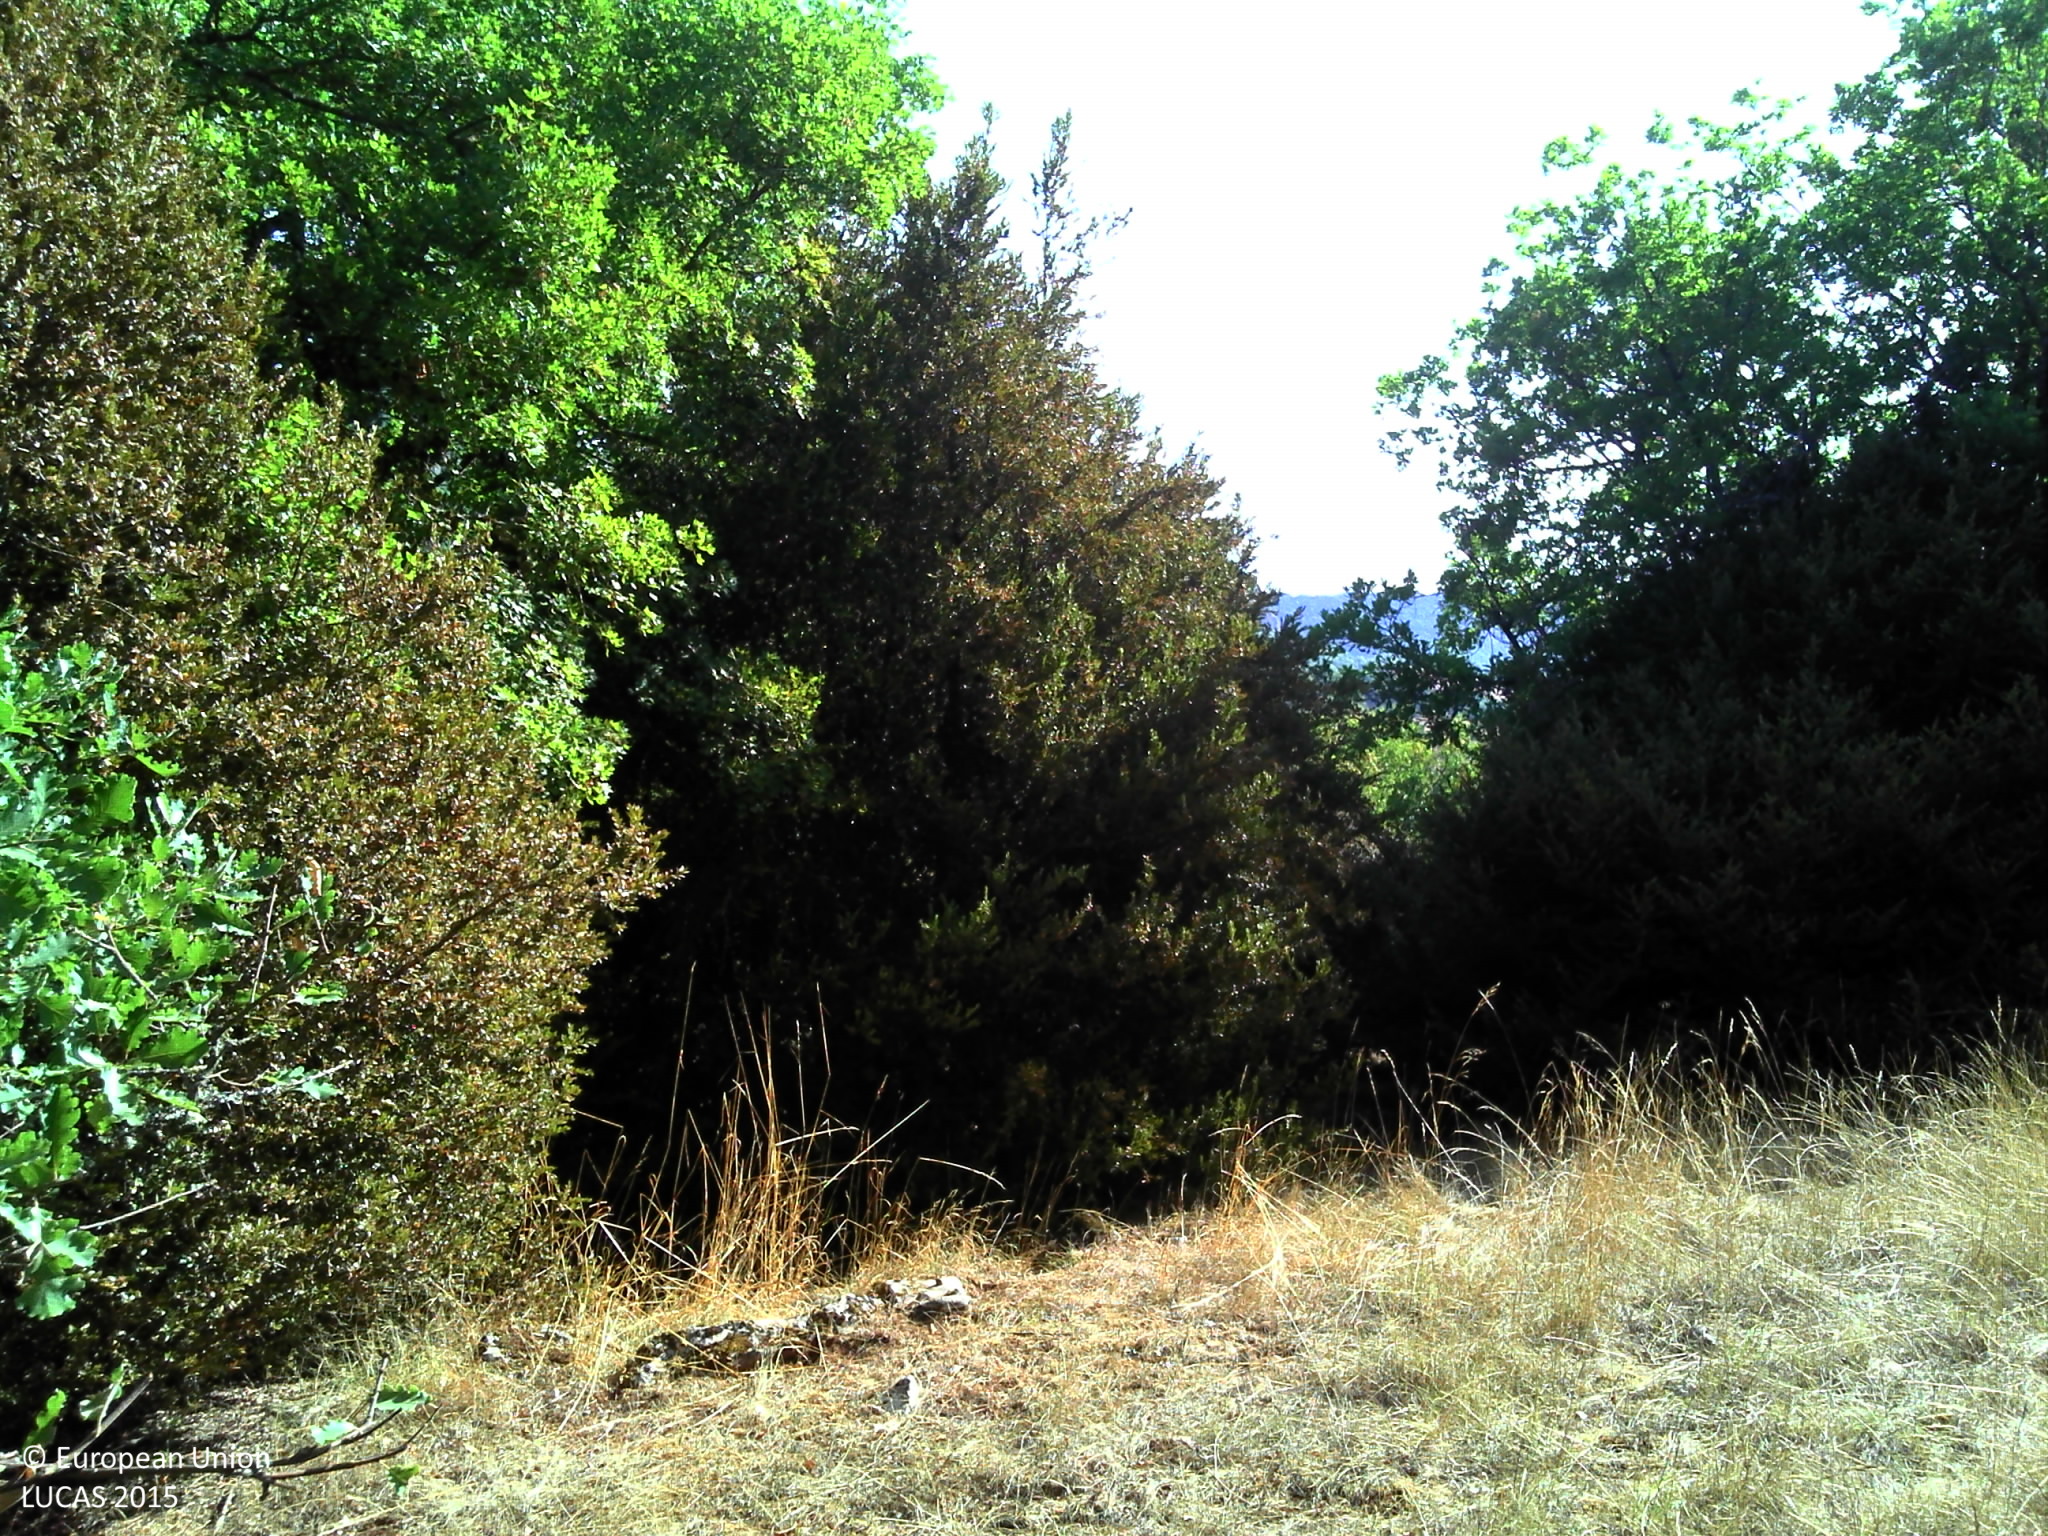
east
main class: Woodland
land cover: Broadleaved woodland
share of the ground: > 75 %
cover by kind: broadleaved forest trees 70 %, herbaceous plants 15 %, shrubs 10 %, lichens and mosses 5 %
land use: Forestry
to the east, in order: Broadleaved woodland; Grassland with sparse tree/shrub cover; Fences; Tracks; Shrubland with sparse tree cover; Broadleaved woodland; Shrubland with sparse tree cover; Spontaneously vegetated surfaces; Fences; Barley; Dry stone walls; Fences; Grass margins; Paved roads, cycling and walking lanes; Grass margins; Fences; Managed hedges; Grassland without tree/shrub cover
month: August
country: FR
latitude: 43.8871
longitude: 3.1235
